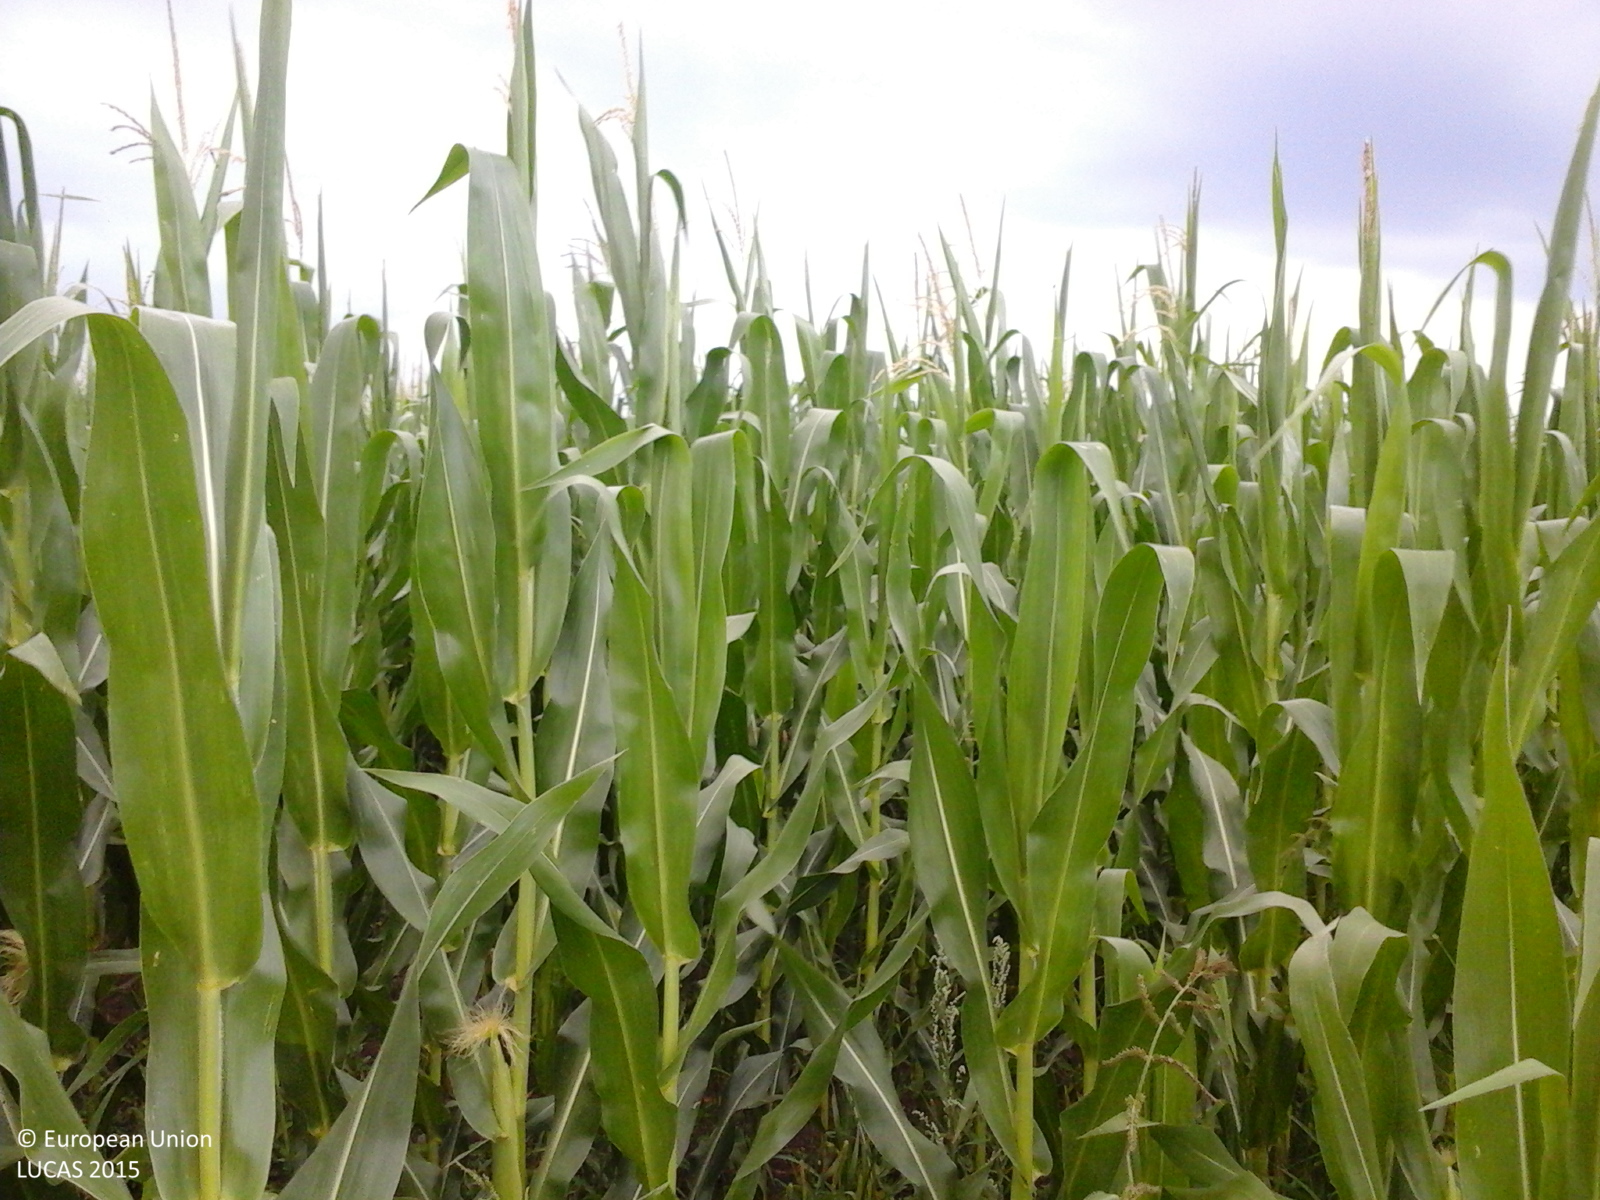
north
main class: Cropland
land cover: Maize
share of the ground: > 75 %
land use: Agriculture (excluding fallow land and kitchen gardens)
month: July
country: RO
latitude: 44.1268
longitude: 24.4004
